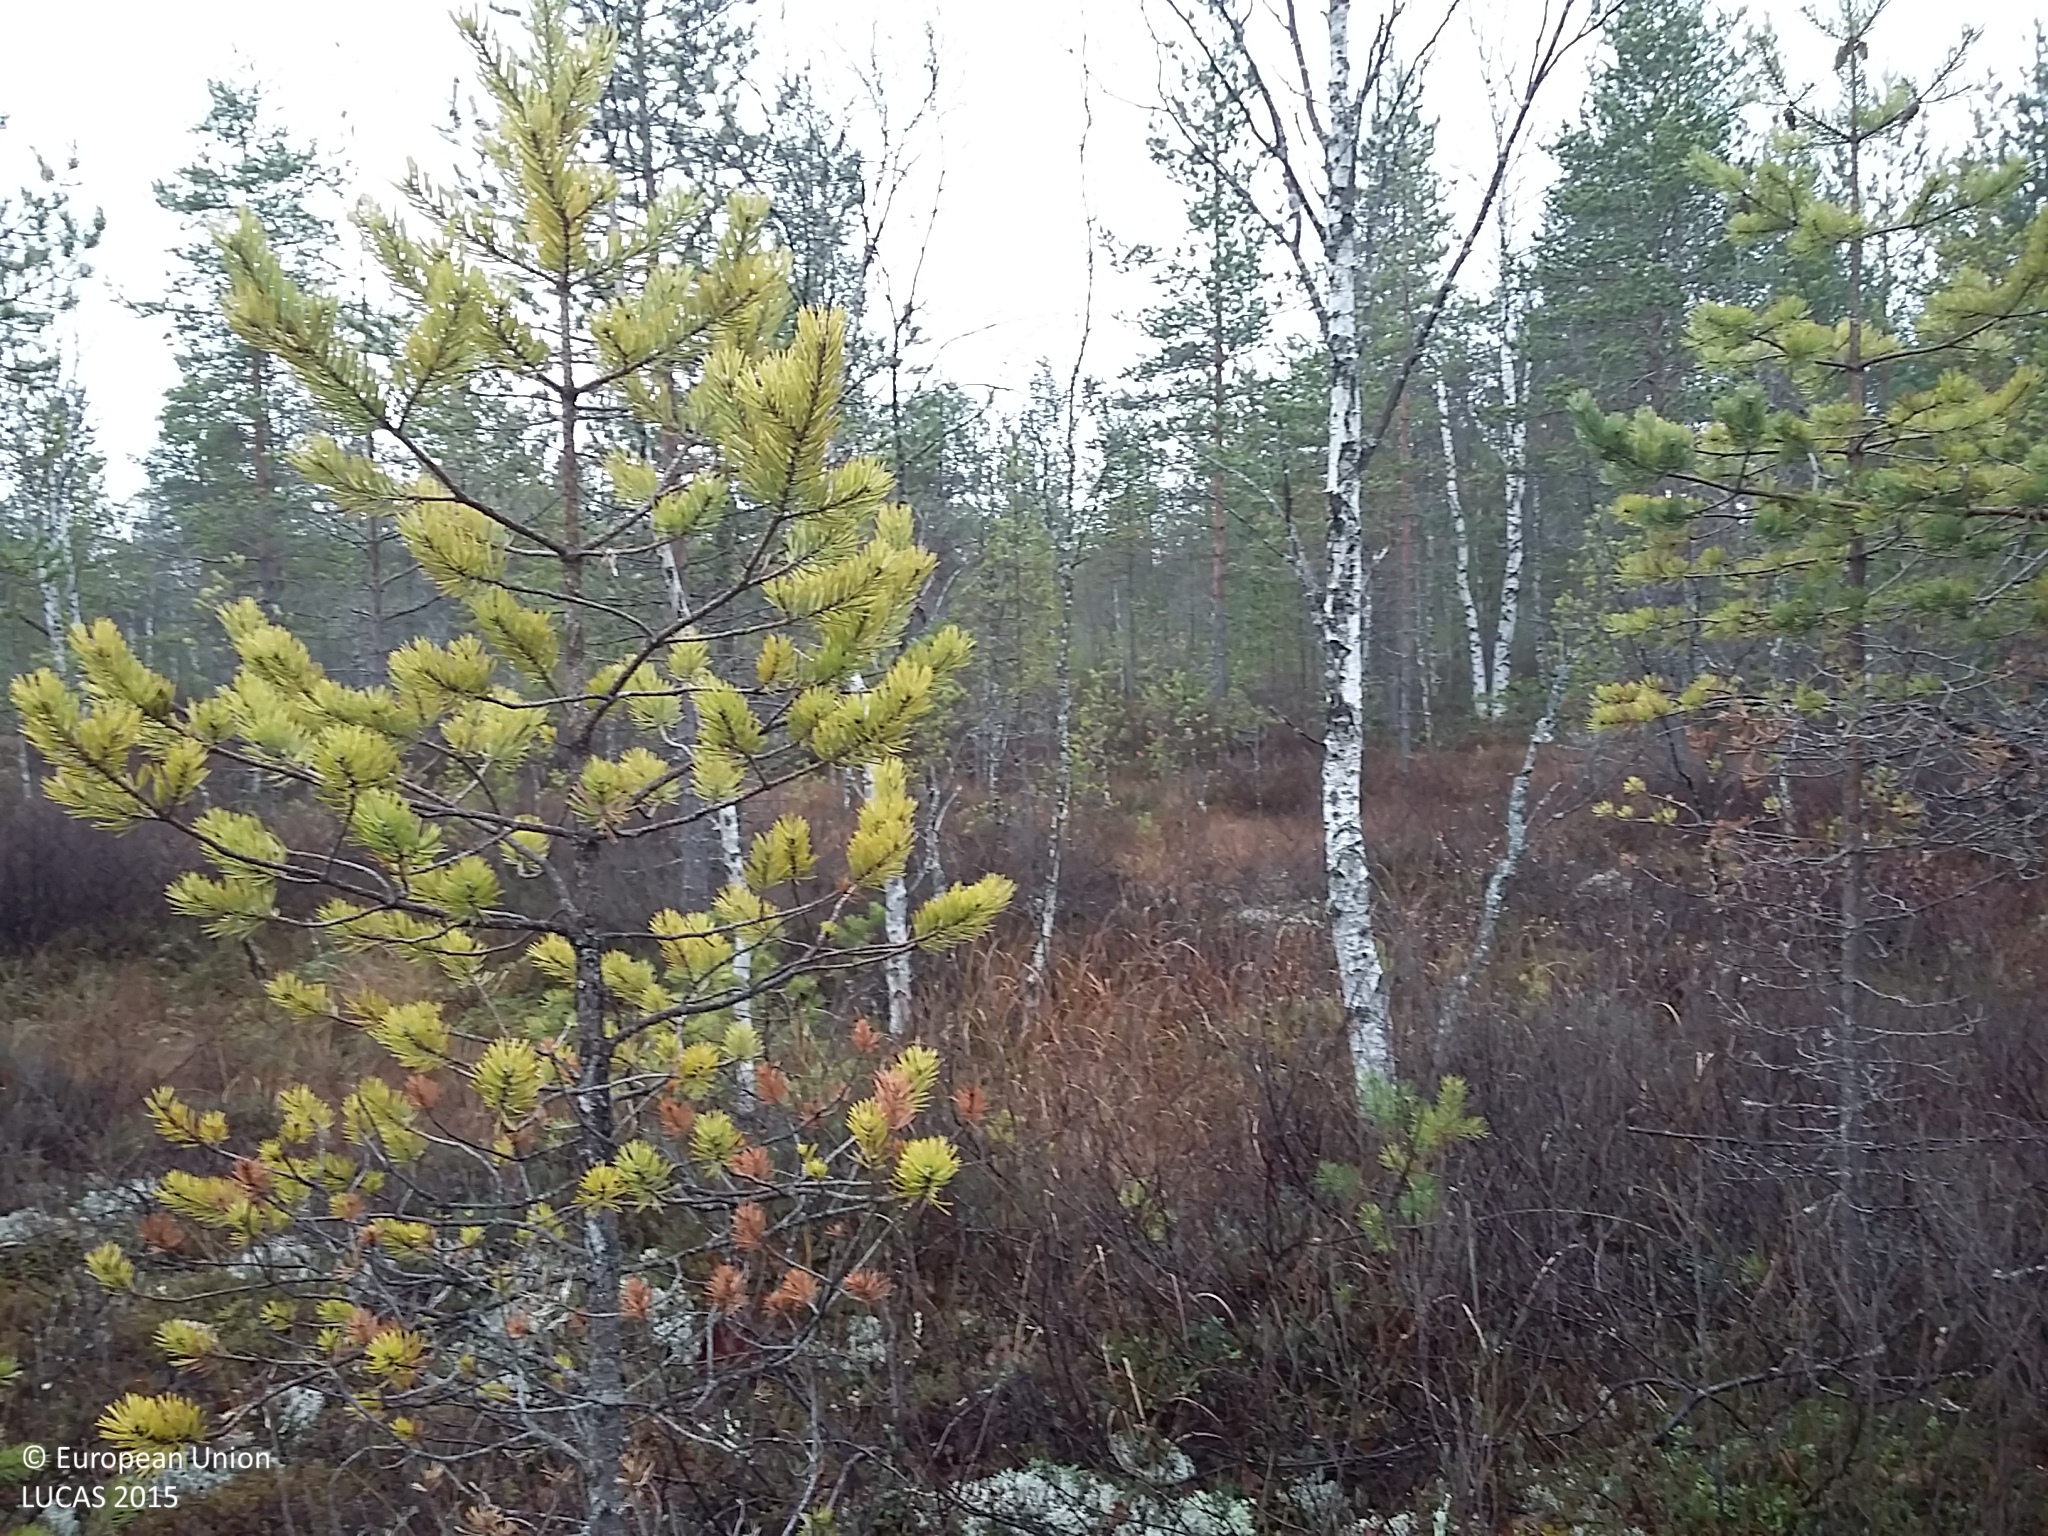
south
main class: Woodland
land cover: Pine dominated coniferous woodland
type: boreal forest
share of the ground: 50 - 75 %
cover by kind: coniferous forest trees 45 %, shrubs 25 %, lichens and mosses 20 %, broadleaved forest trees 5 %, herbaceous plants 5 %
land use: Forestry
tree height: > 5 m
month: October
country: FI
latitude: 64.4350
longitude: 25.3953
